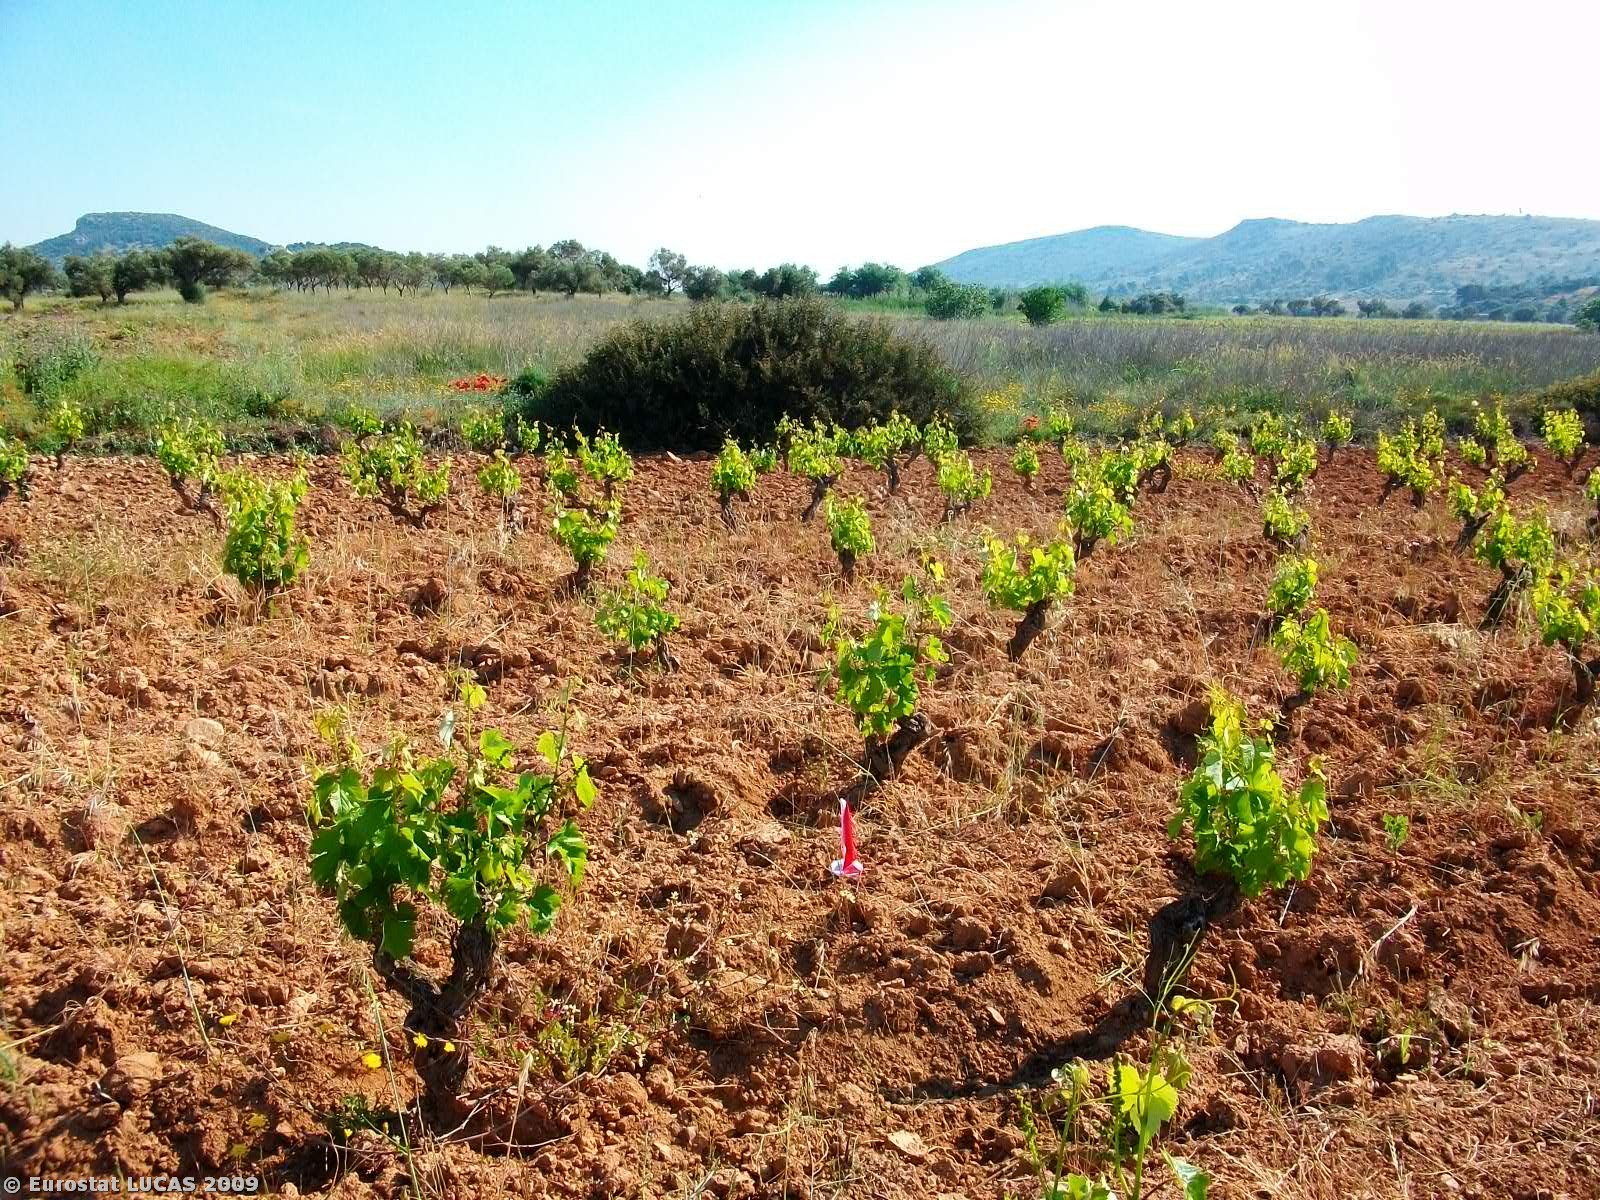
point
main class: Cropland
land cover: Vineyards
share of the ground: 25 - 50 %
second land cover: Bare land
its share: > 75 %
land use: Agriculture (excluding fallow land and kitchen gardens)
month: May
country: GR
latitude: 37.9808
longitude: 23.9523
